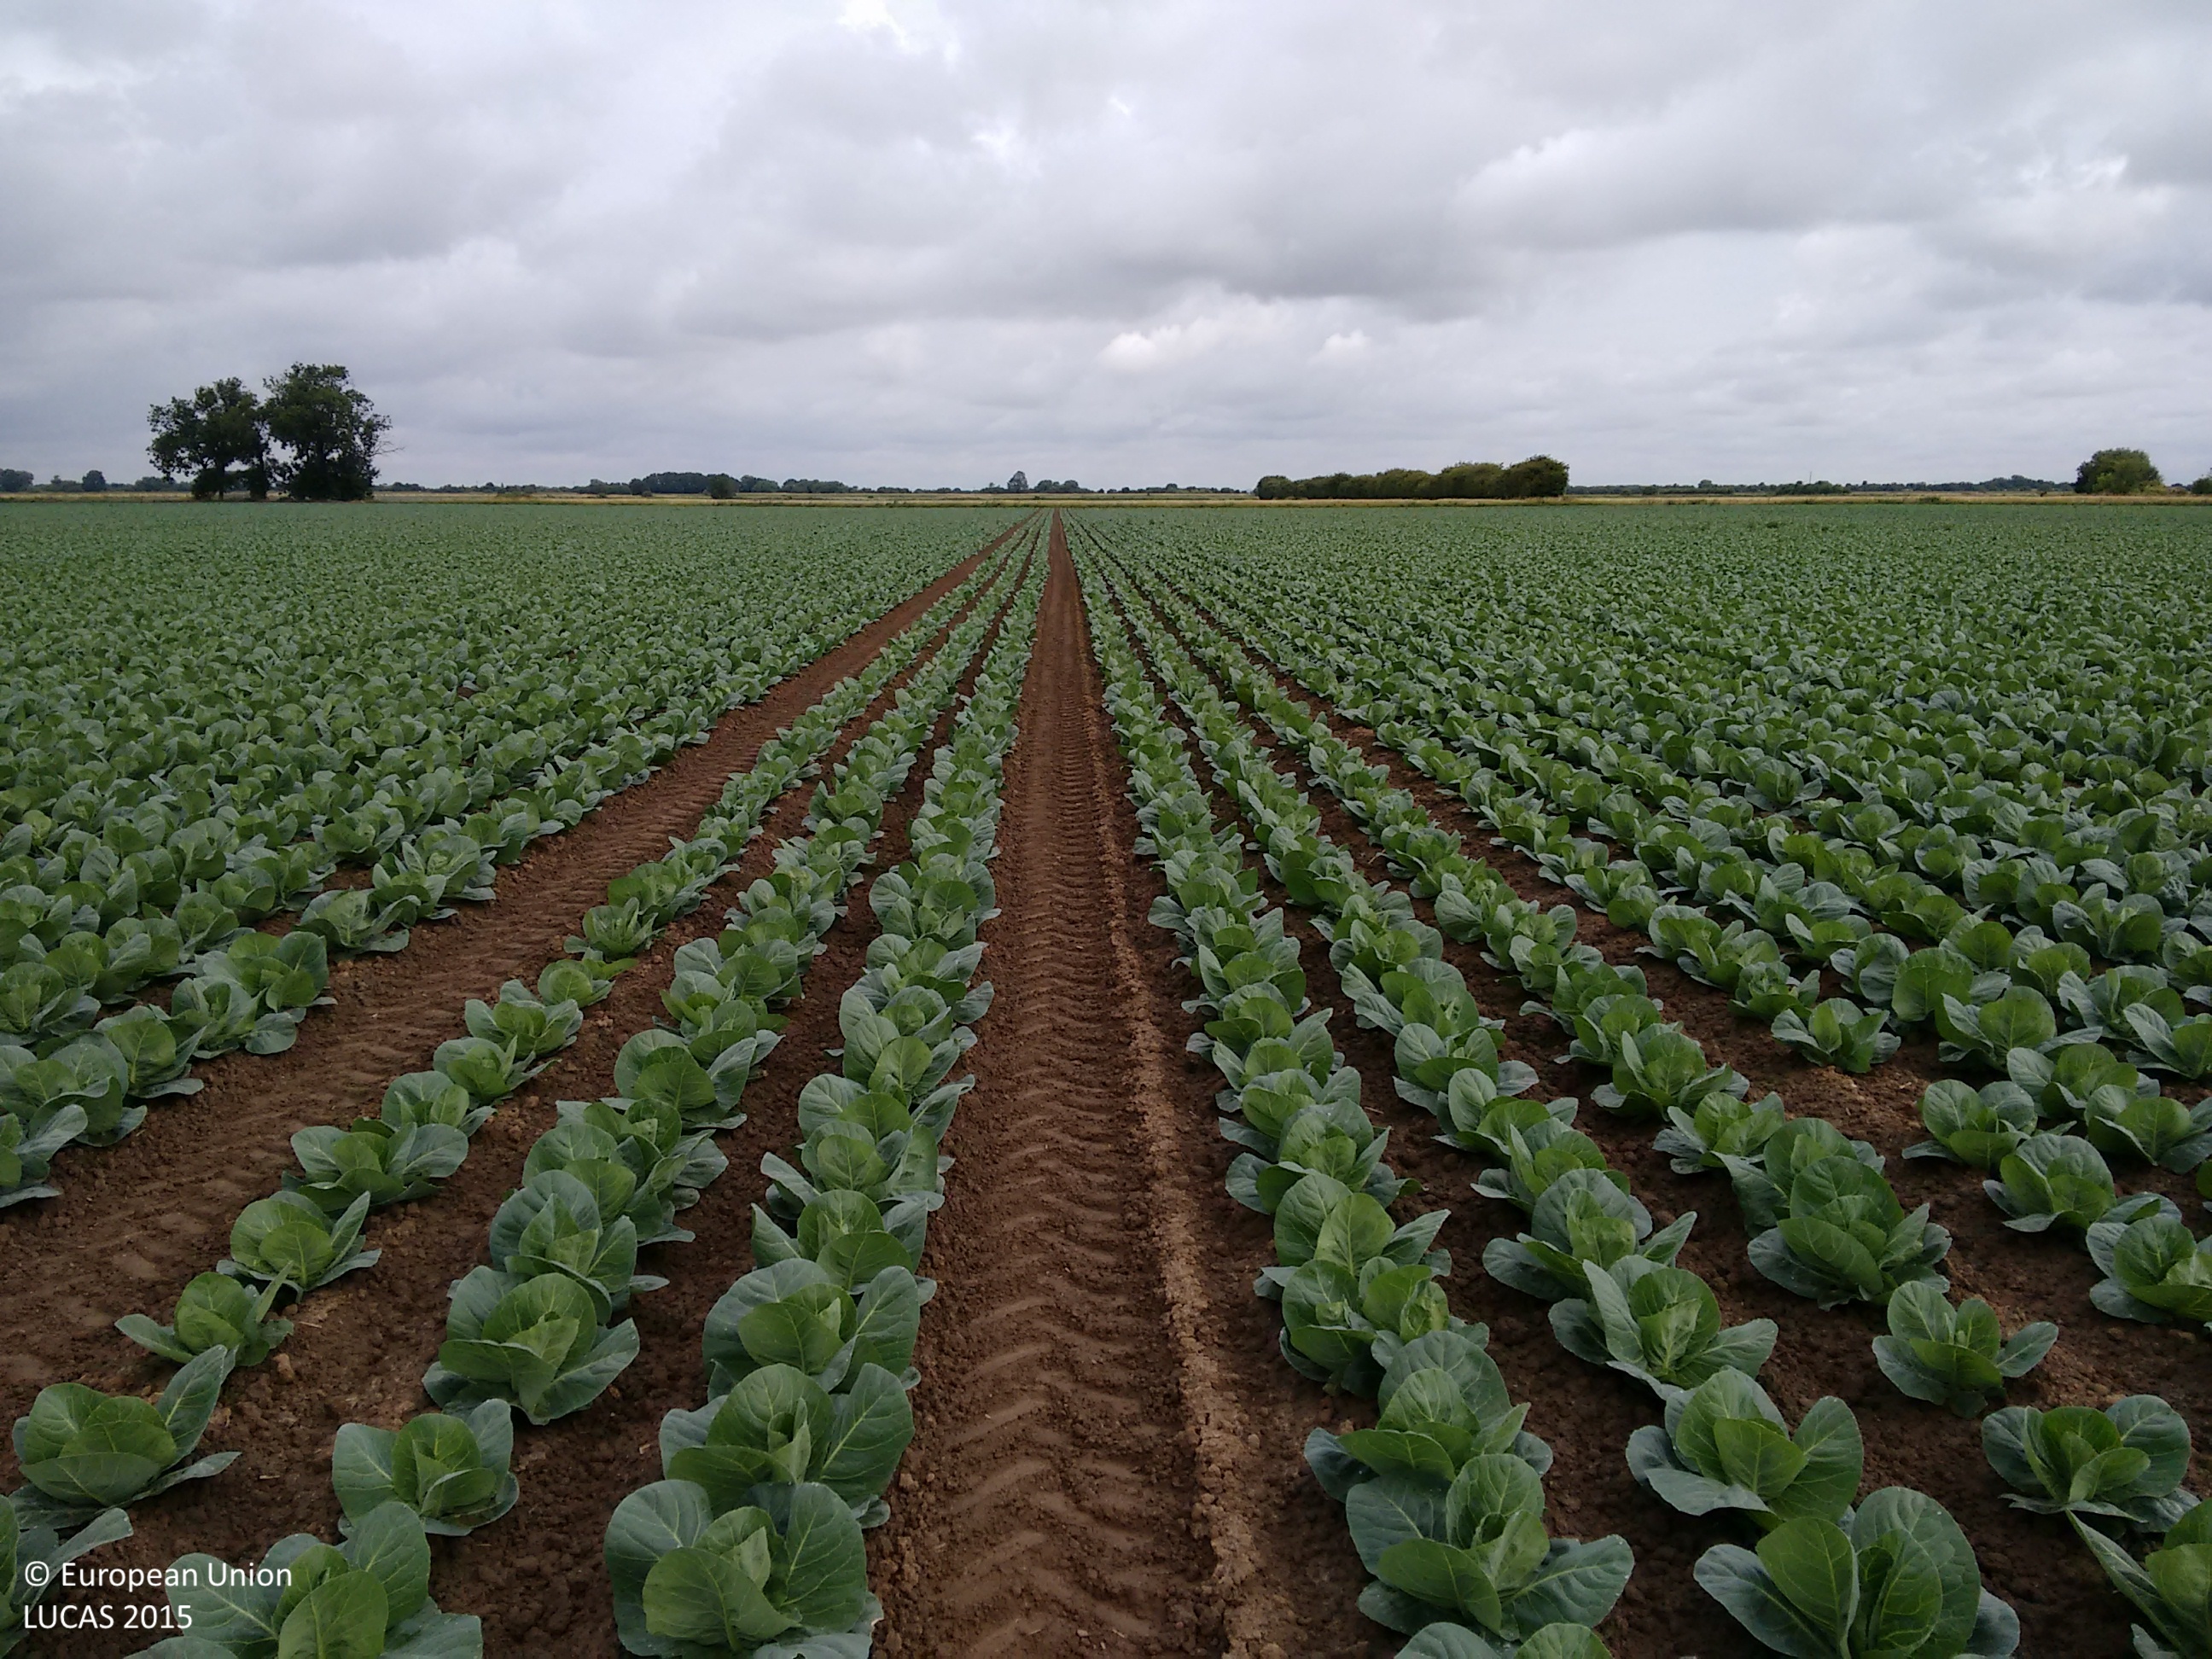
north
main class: Cropland
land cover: Other fresh vegetables
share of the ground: 50 - 75 %
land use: Agriculture (excluding fallow land and kitchen gardens)
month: July
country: GB
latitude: 52.9975
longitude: -0.0905
